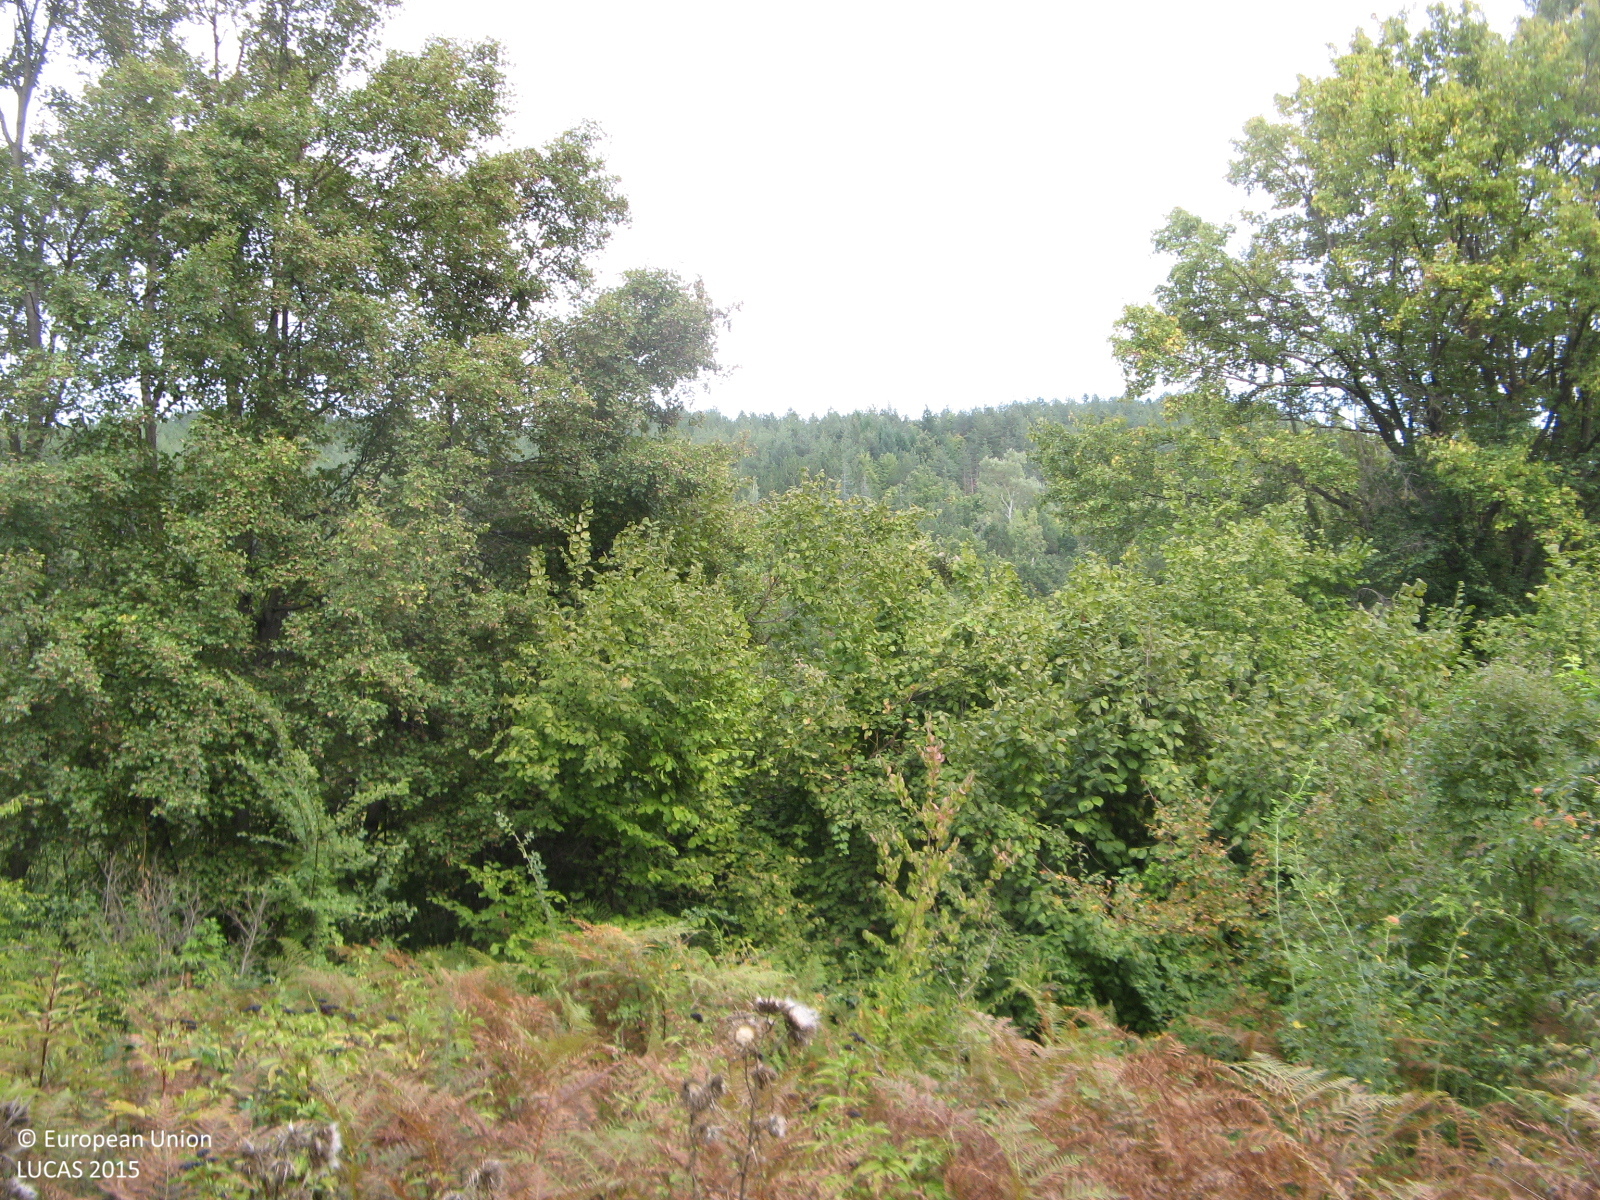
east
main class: Woodland
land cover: Broadleaved woodland
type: thermophilous deciduous forest
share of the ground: > 75 %
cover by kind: broadleaved forest trees 85 %, shrubs 10 %, herbaceous plants 5 %
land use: Semi-natural and natural areas not in use
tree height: > 5 m
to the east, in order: Broadleaved woodland; Rivers and streams; Broadleaved woodland; Paved roads, cycling and walking lanes; Rocks and stones; Pine dominated coniferous woodland
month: October
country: BG
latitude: 41.7133
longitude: 25.3577
